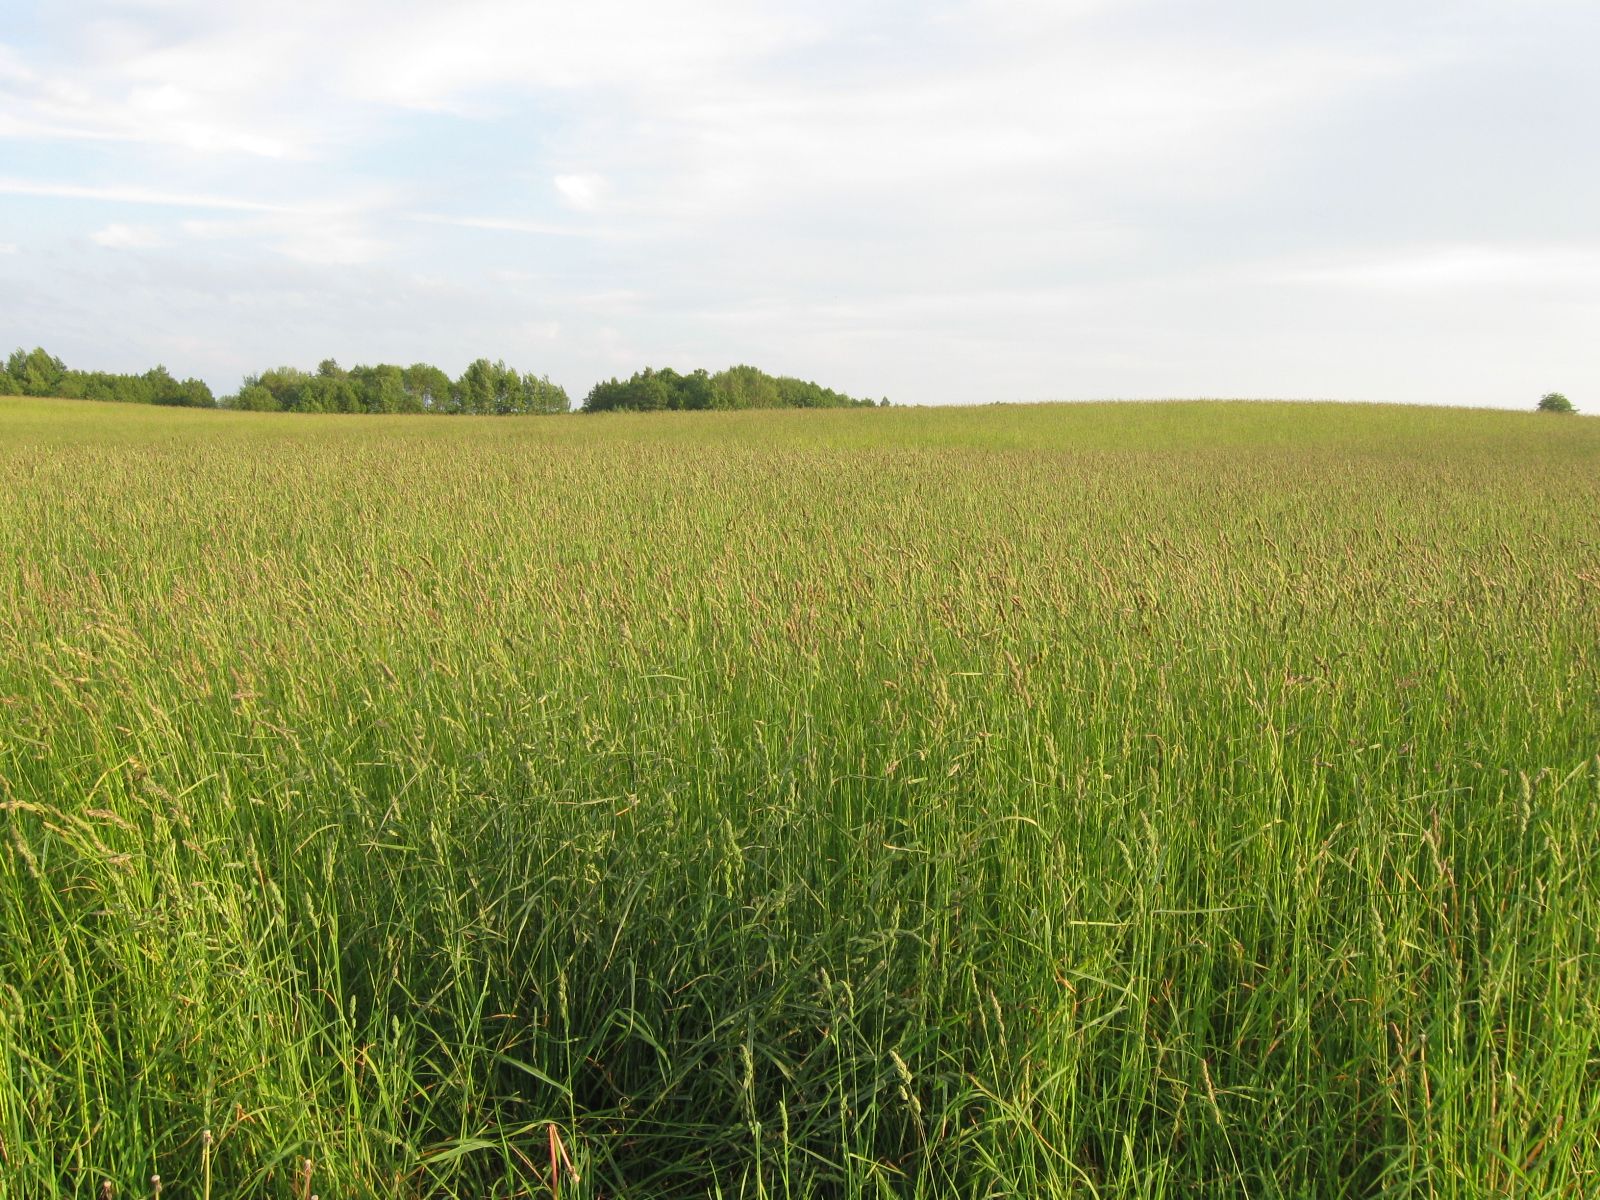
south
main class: Grassland
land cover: Grassland without tree/shrub cover
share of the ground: > 75 %
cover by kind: herbaceous plants 100 %
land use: Agriculture (excluding fallow land and kitchen gardens)
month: June
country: LT
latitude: 54.2533
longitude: 23.6070
